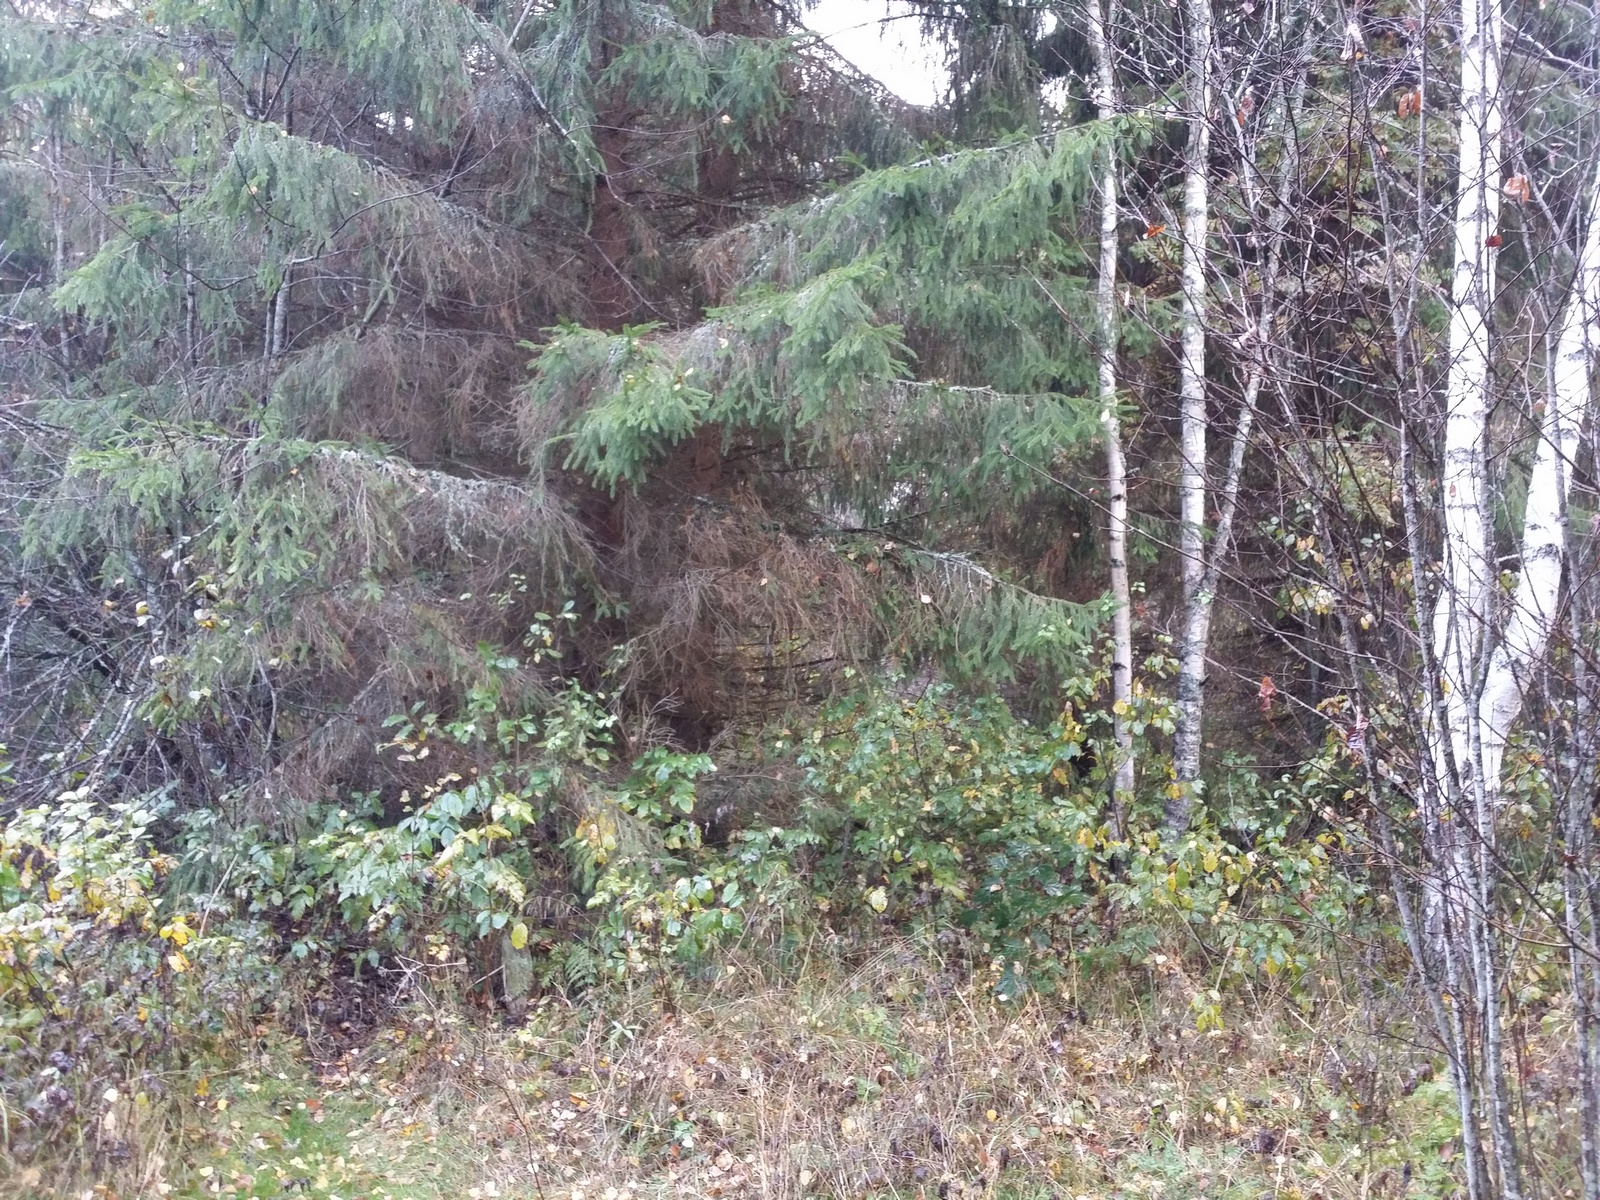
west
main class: Woodland
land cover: Spruce dominated mixed woodland
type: hemiboreal forest and nemoral coniferous forest and mixed broadleaved-coniferous forest
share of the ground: 50 - 75 %
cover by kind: coniferous forest trees 40 %, broadleaved forest trees 25 %, shrubs 15 %, herbaceous plants 10 %, lichens and mosses 10 %
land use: Forestry
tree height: > 5 m
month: September
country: LV
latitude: 57.4944
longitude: 27.4061
